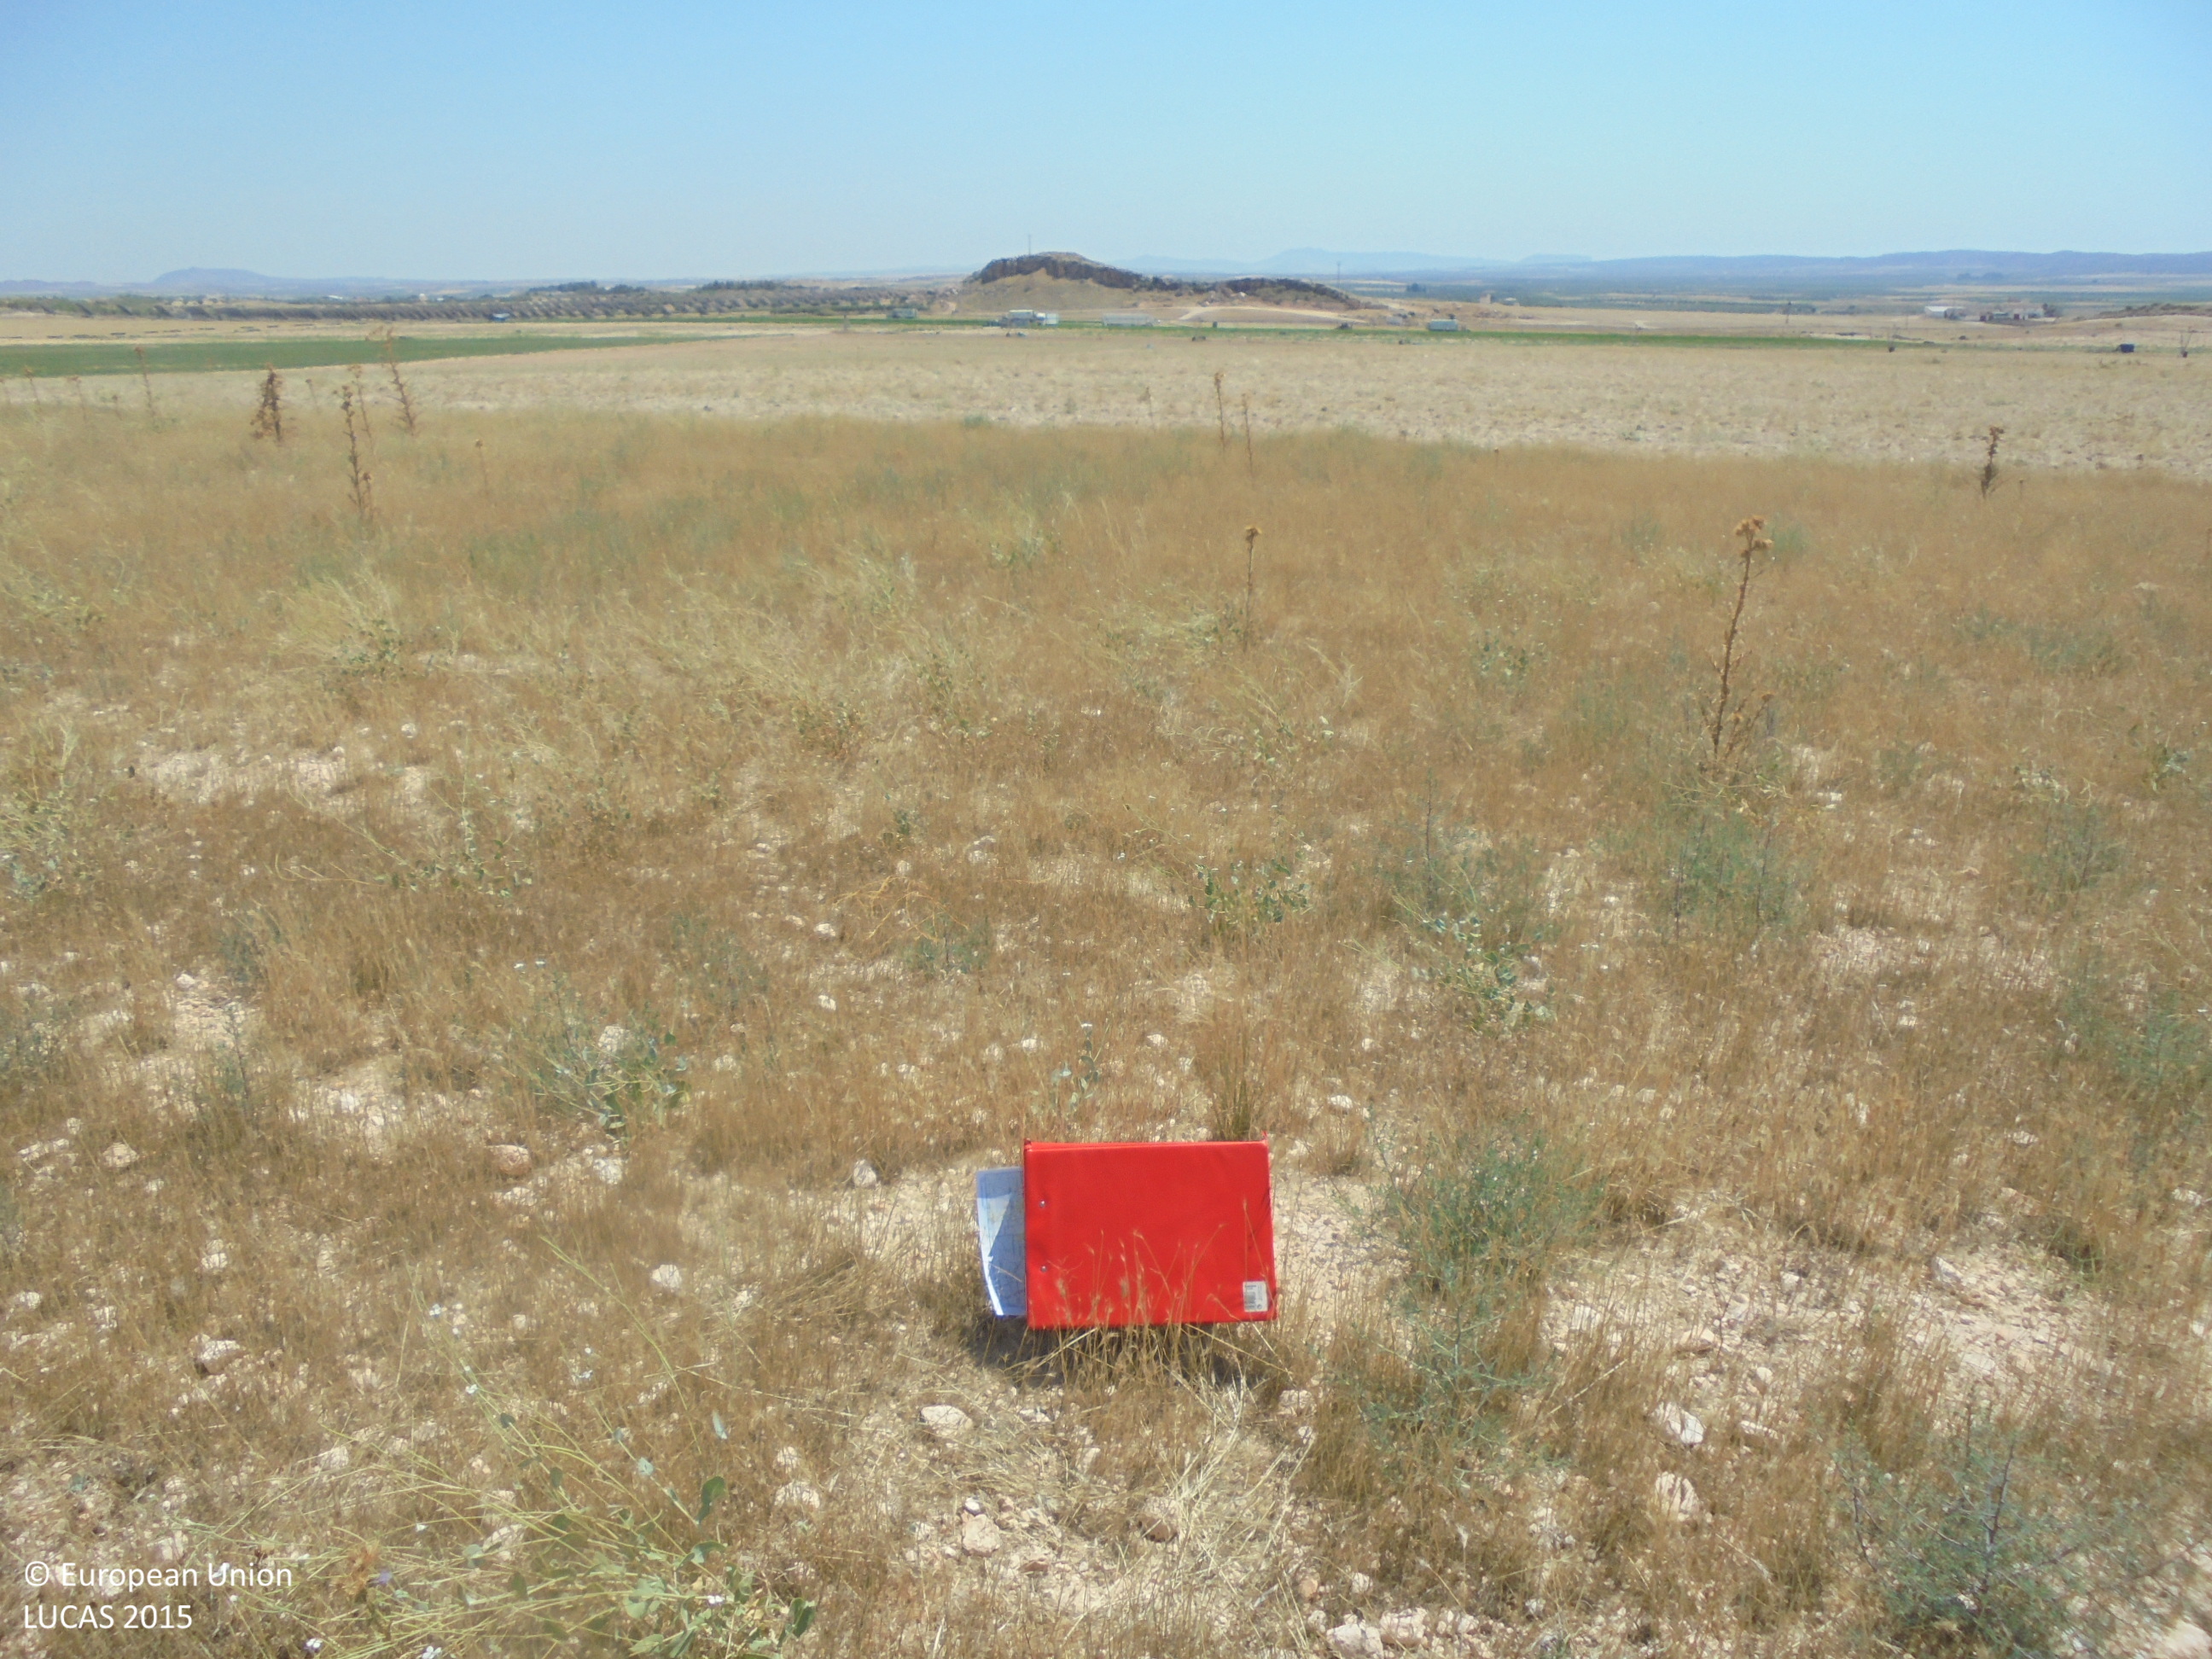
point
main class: Grassland
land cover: Spontaneously vegetated surfaces
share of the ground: > 75 %
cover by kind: herbaceous plants 80 %, unconsolidated bare surface 20 %
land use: Fallow land
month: July
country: ES
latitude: 38.5597
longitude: -1.5492
